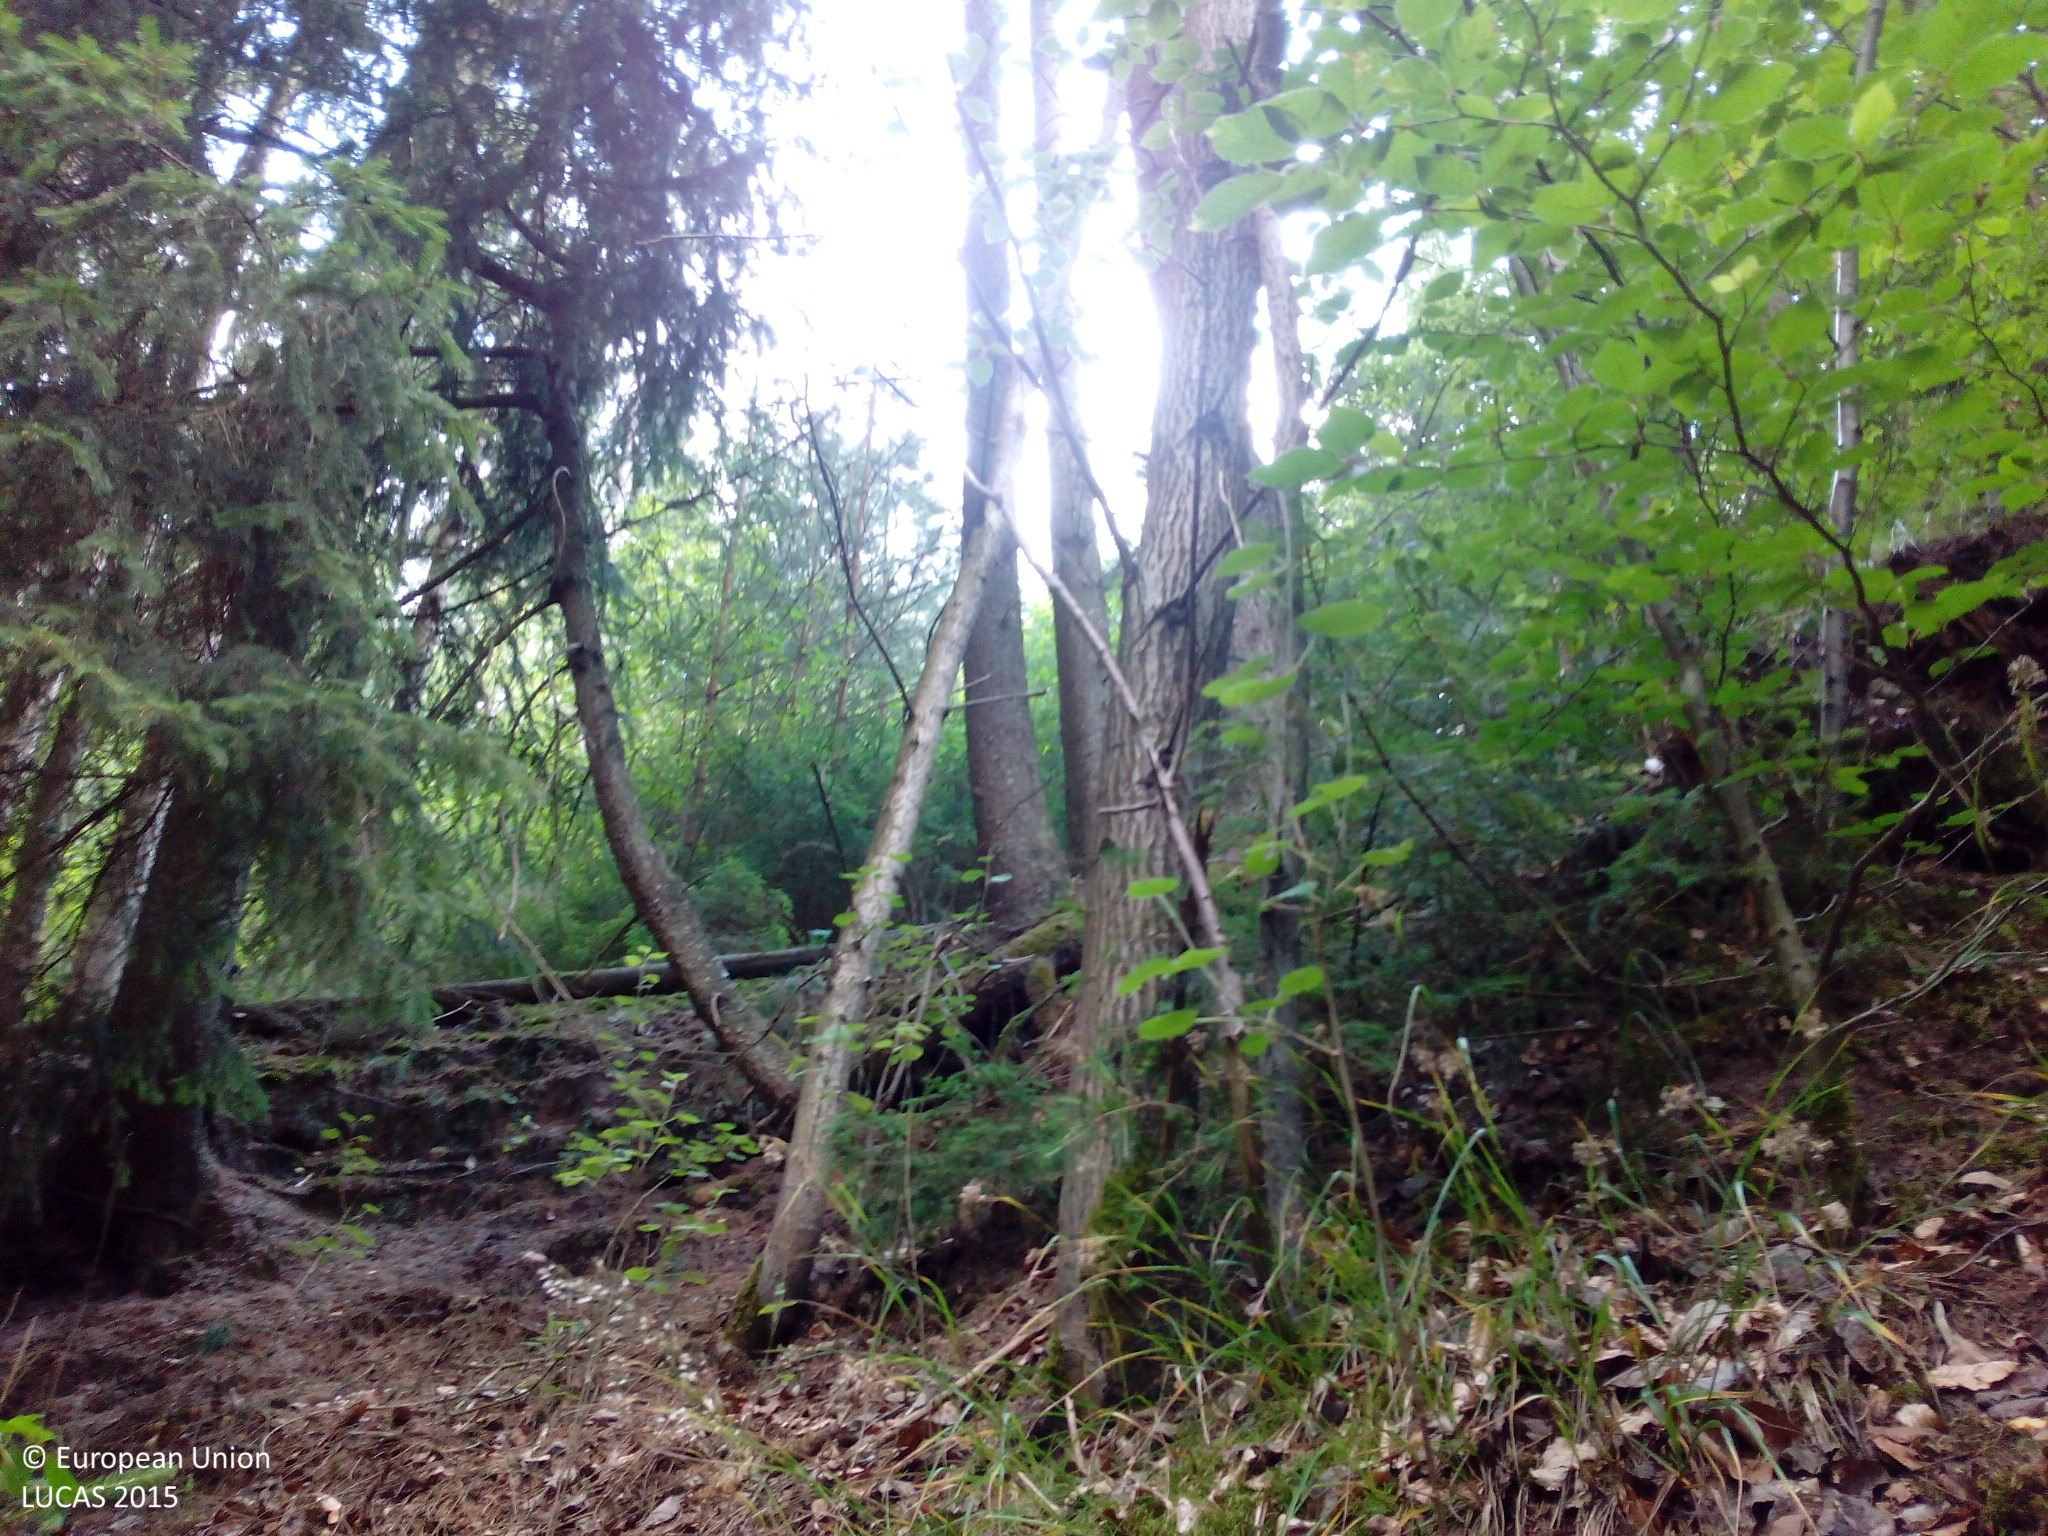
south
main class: Woodland
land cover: Spruce dominated mixed woodland
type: hemiboreal forest and nemoral coniferous forest and mixed broadleaved-coniferous forest
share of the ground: > 75 %
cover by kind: coniferous forest trees 60 %, broadleaved forest trees 20 %, unconsolidated bare surface 10 %, shrubs 5 %, herbaceous plants 5 %
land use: Forestry
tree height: > 5 m
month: July
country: DE
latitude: 49.1317
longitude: 7.5199
